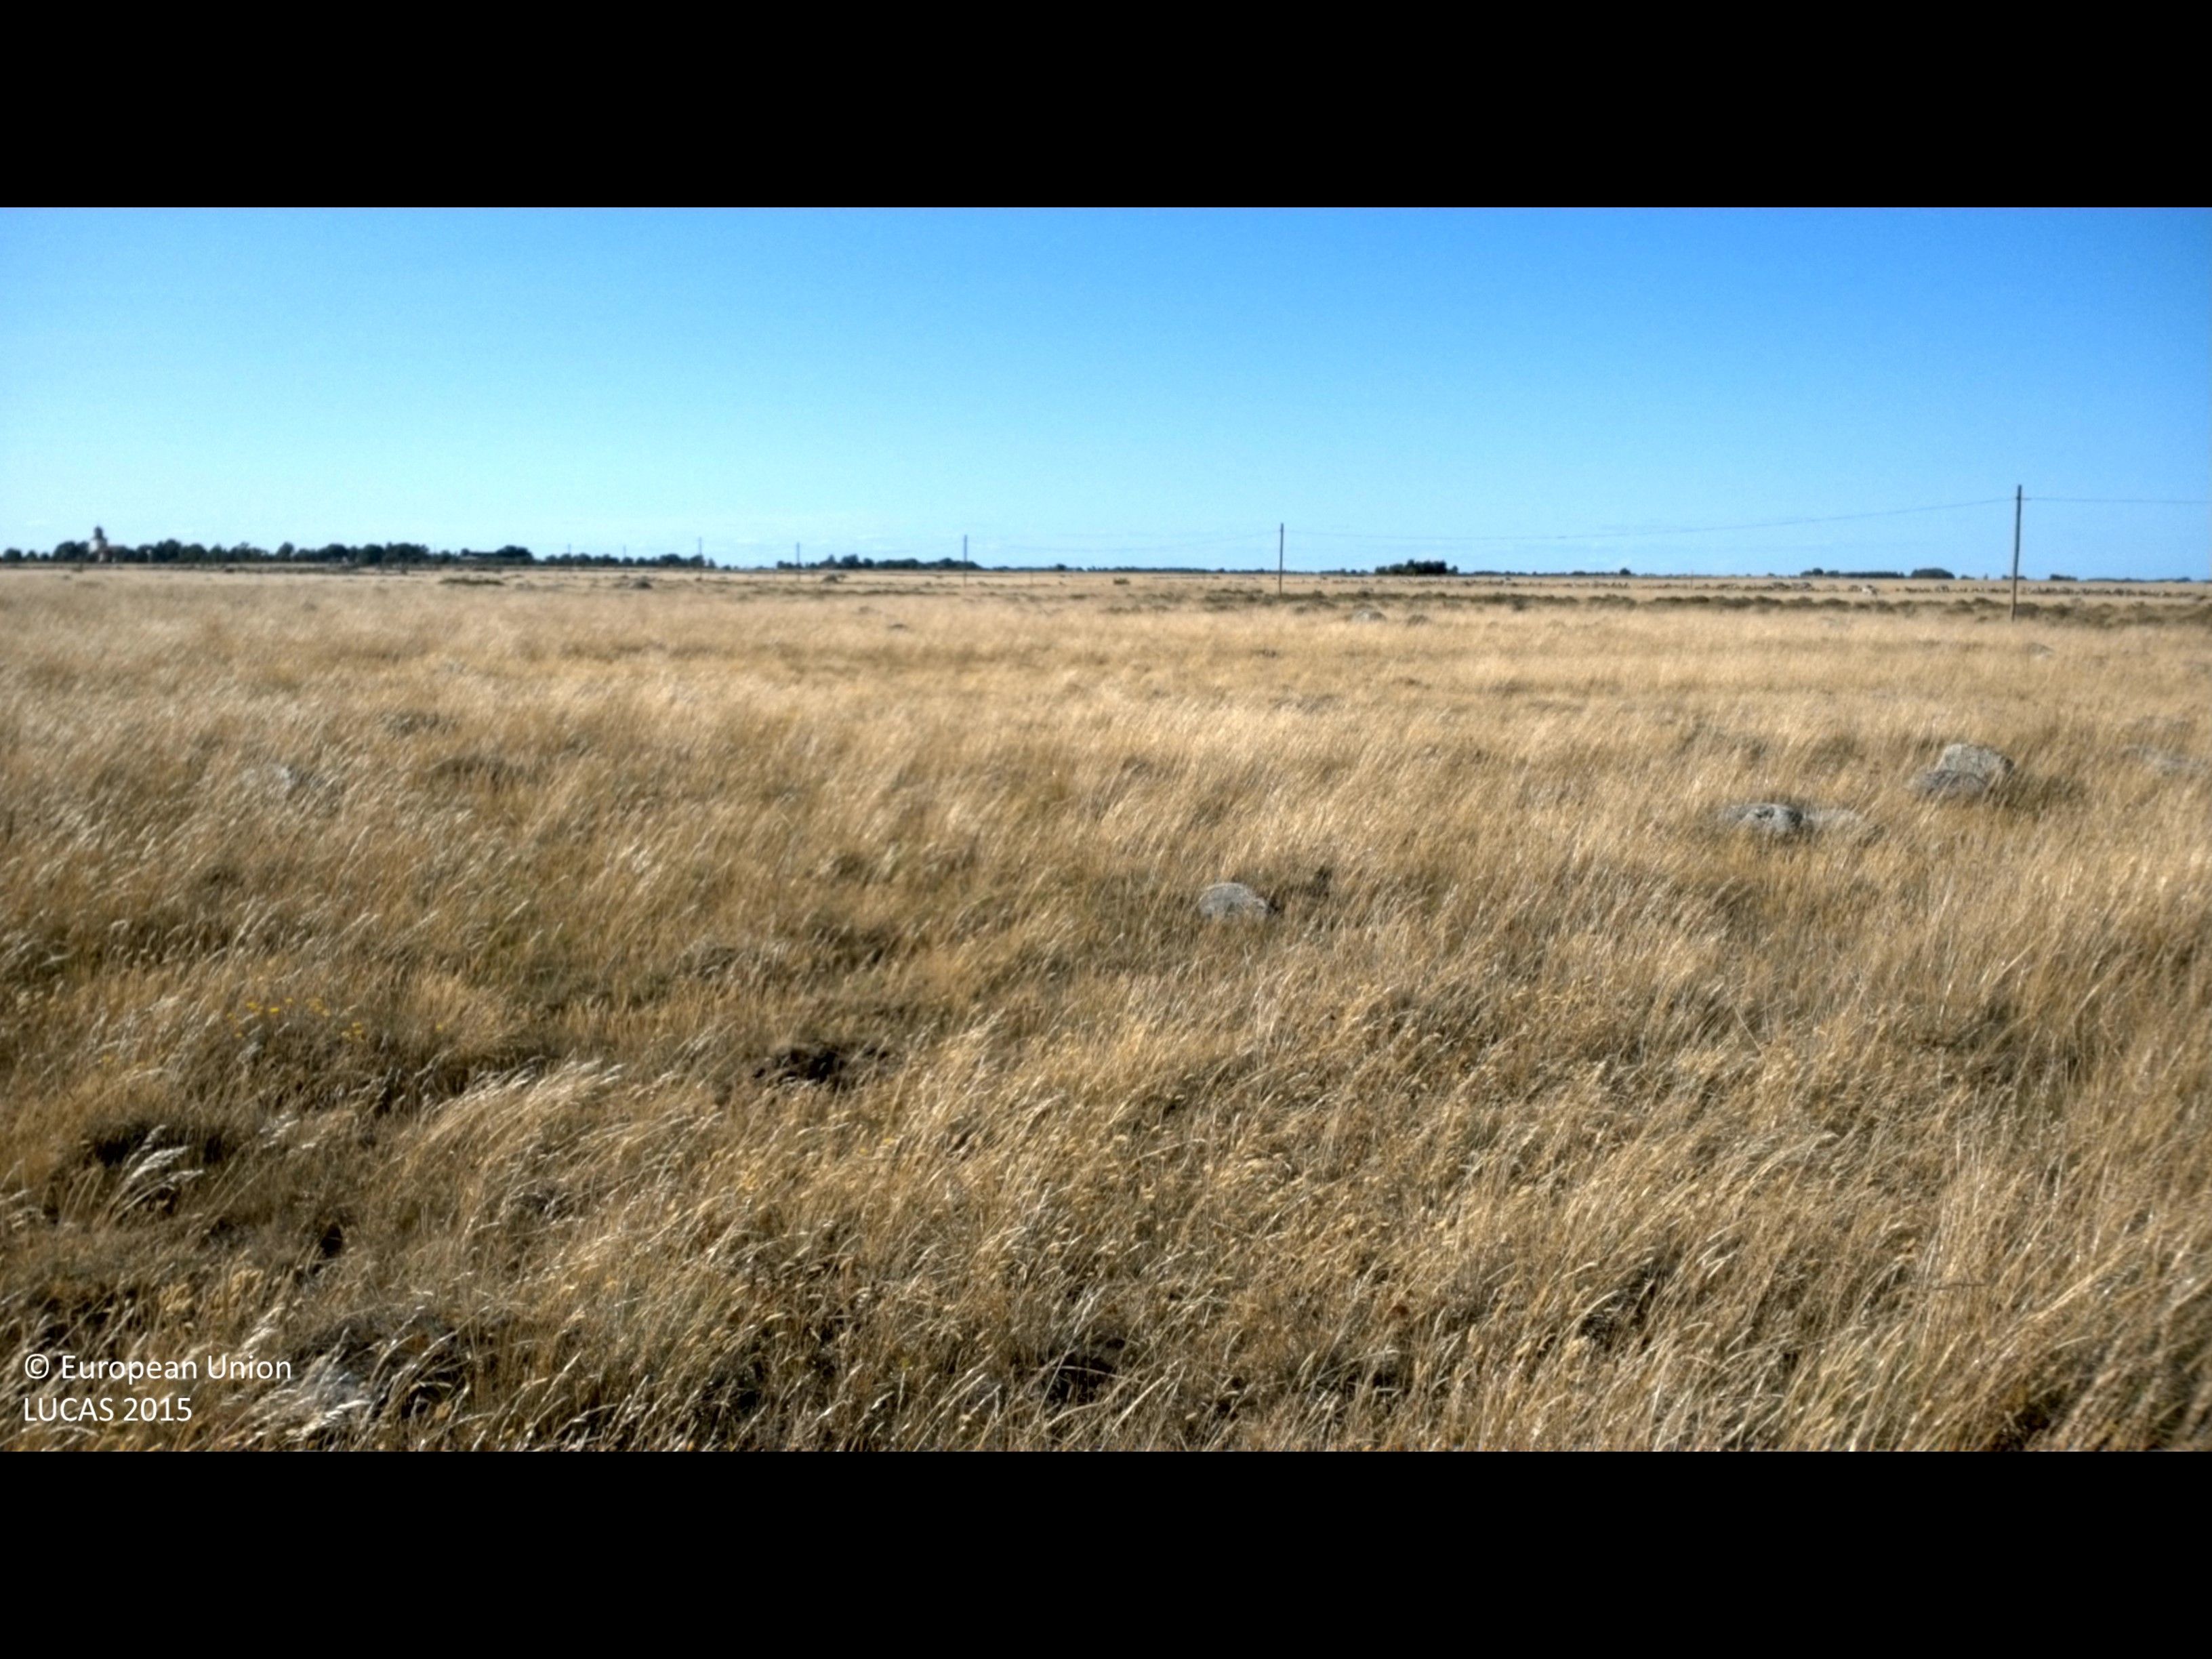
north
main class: Grassland
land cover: Grassland without tree/shrub cover
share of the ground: > 75 %
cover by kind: herbaceous plants 100 %
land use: Agriculture (excluding fallow land and kitchen gardens)
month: July
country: SE
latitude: 56.5044
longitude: 16.6148
